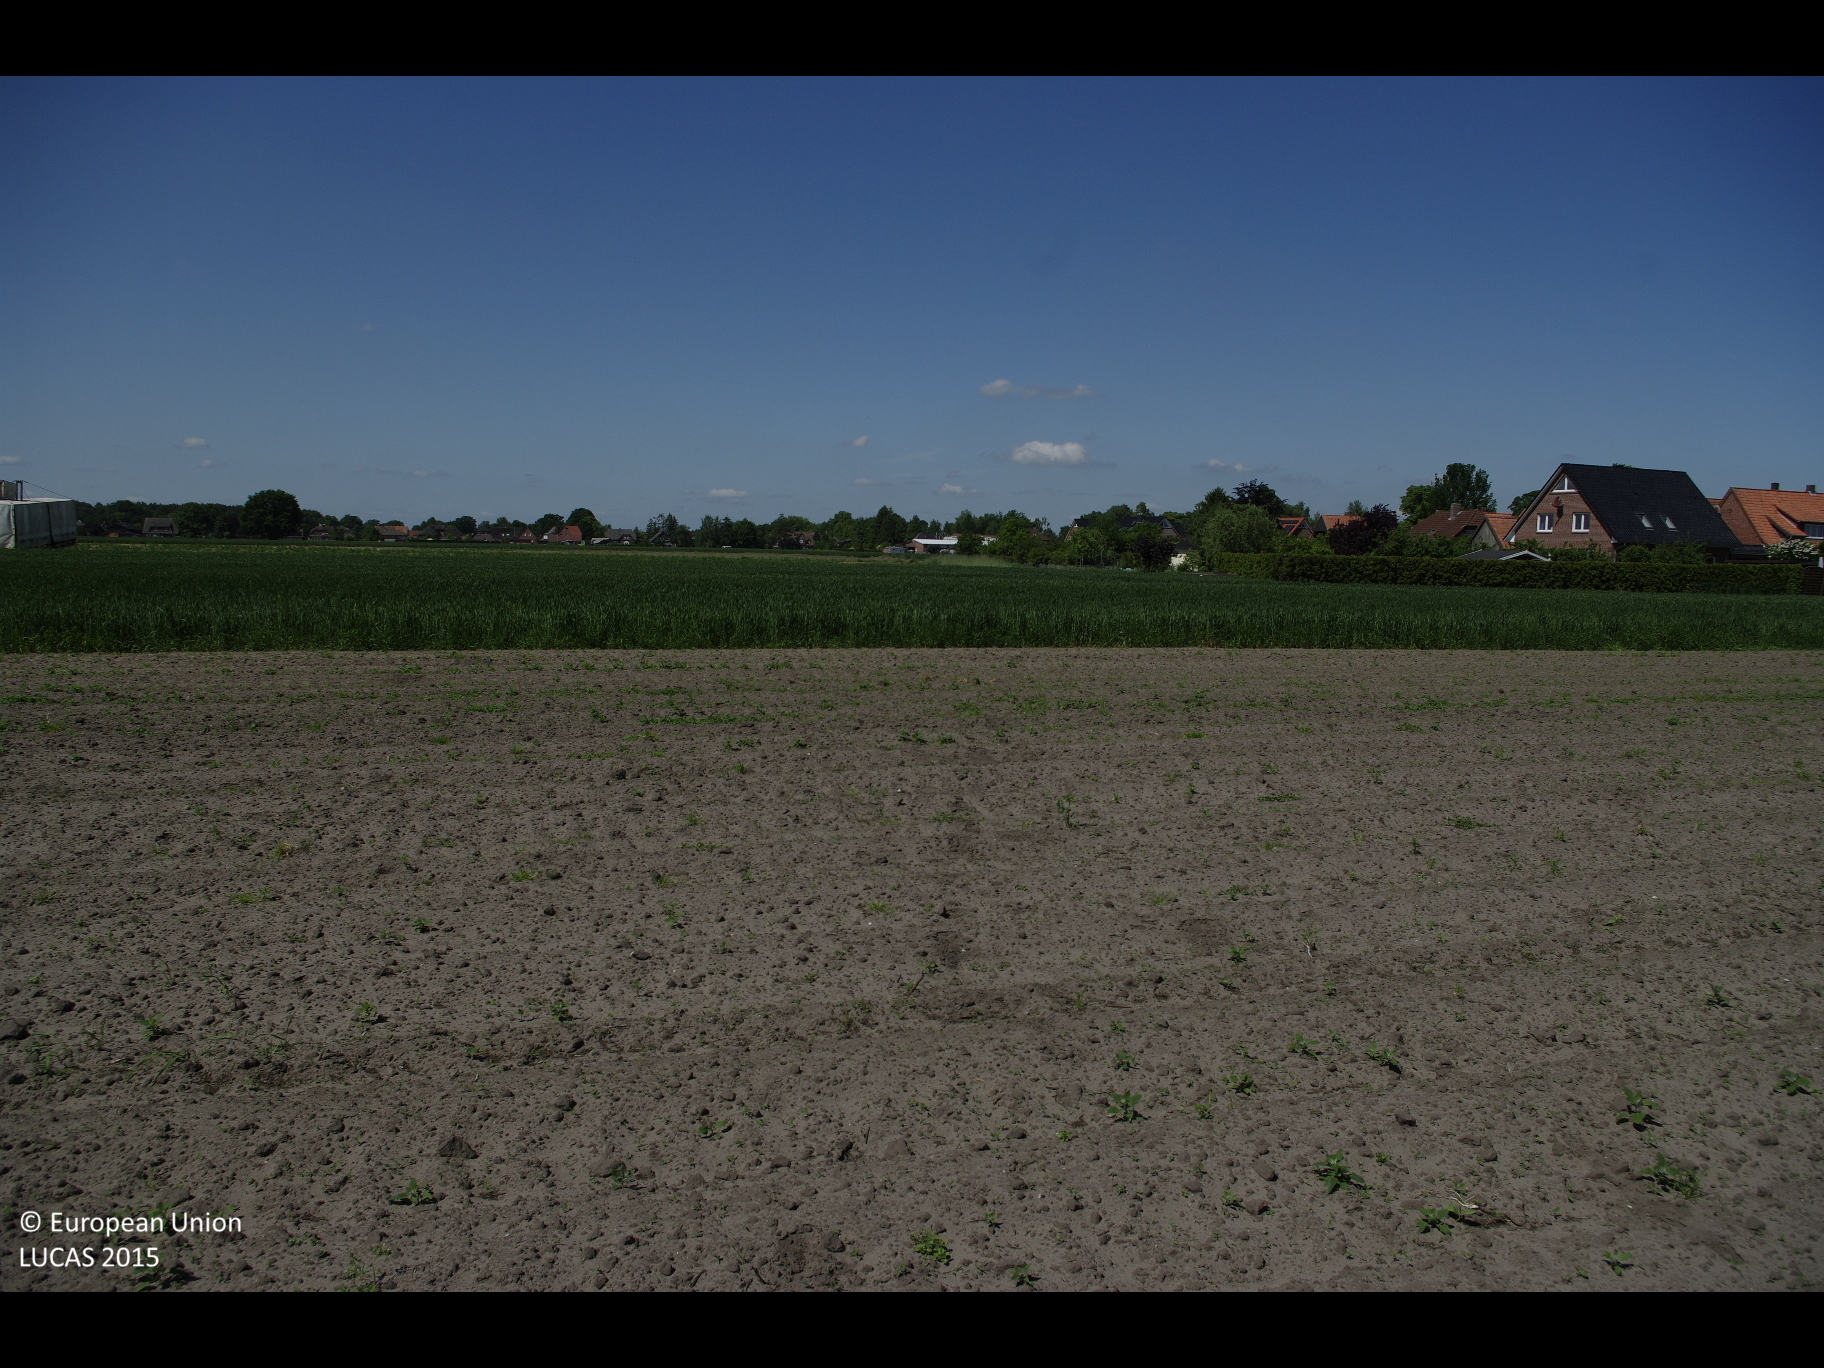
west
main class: Cropland
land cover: Maize
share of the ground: < 10 %
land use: Agriculture (excluding fallow land and kitchen gardens)
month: June
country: DE
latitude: 53.3294
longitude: 10.3752
